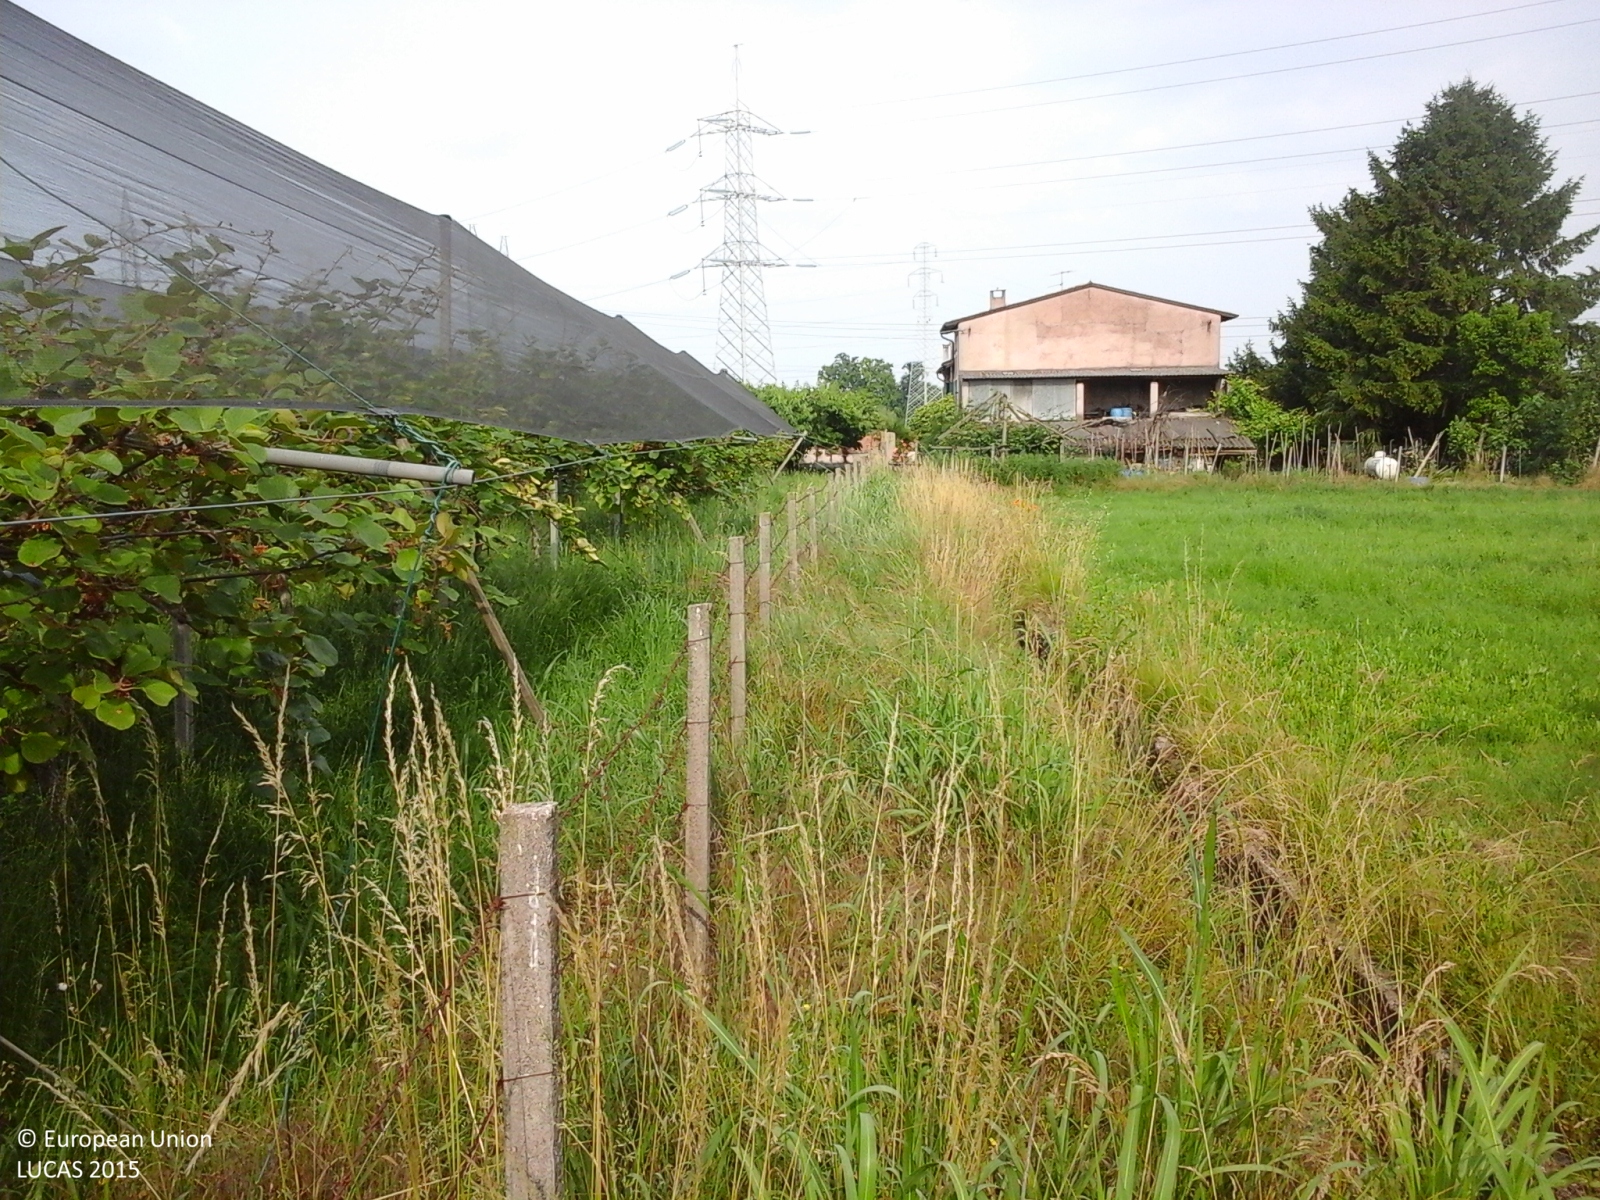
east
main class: Cropland
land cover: Other fruit trees and berries
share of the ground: > 75 %
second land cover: Grassland without tree/shrub cover
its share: > 75 %
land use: Agriculture (excluding fallow land and kitchen gardens)
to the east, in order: Other fruit trees and berries; Grassland without tree/shrub cover; Cherry fruit; Artificial constructions in urban areas; Grassland without tree/shrub cover; Electric lines; Grassland without tree/shrub cover
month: June
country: IT
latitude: 45.4651
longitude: 10.8299
